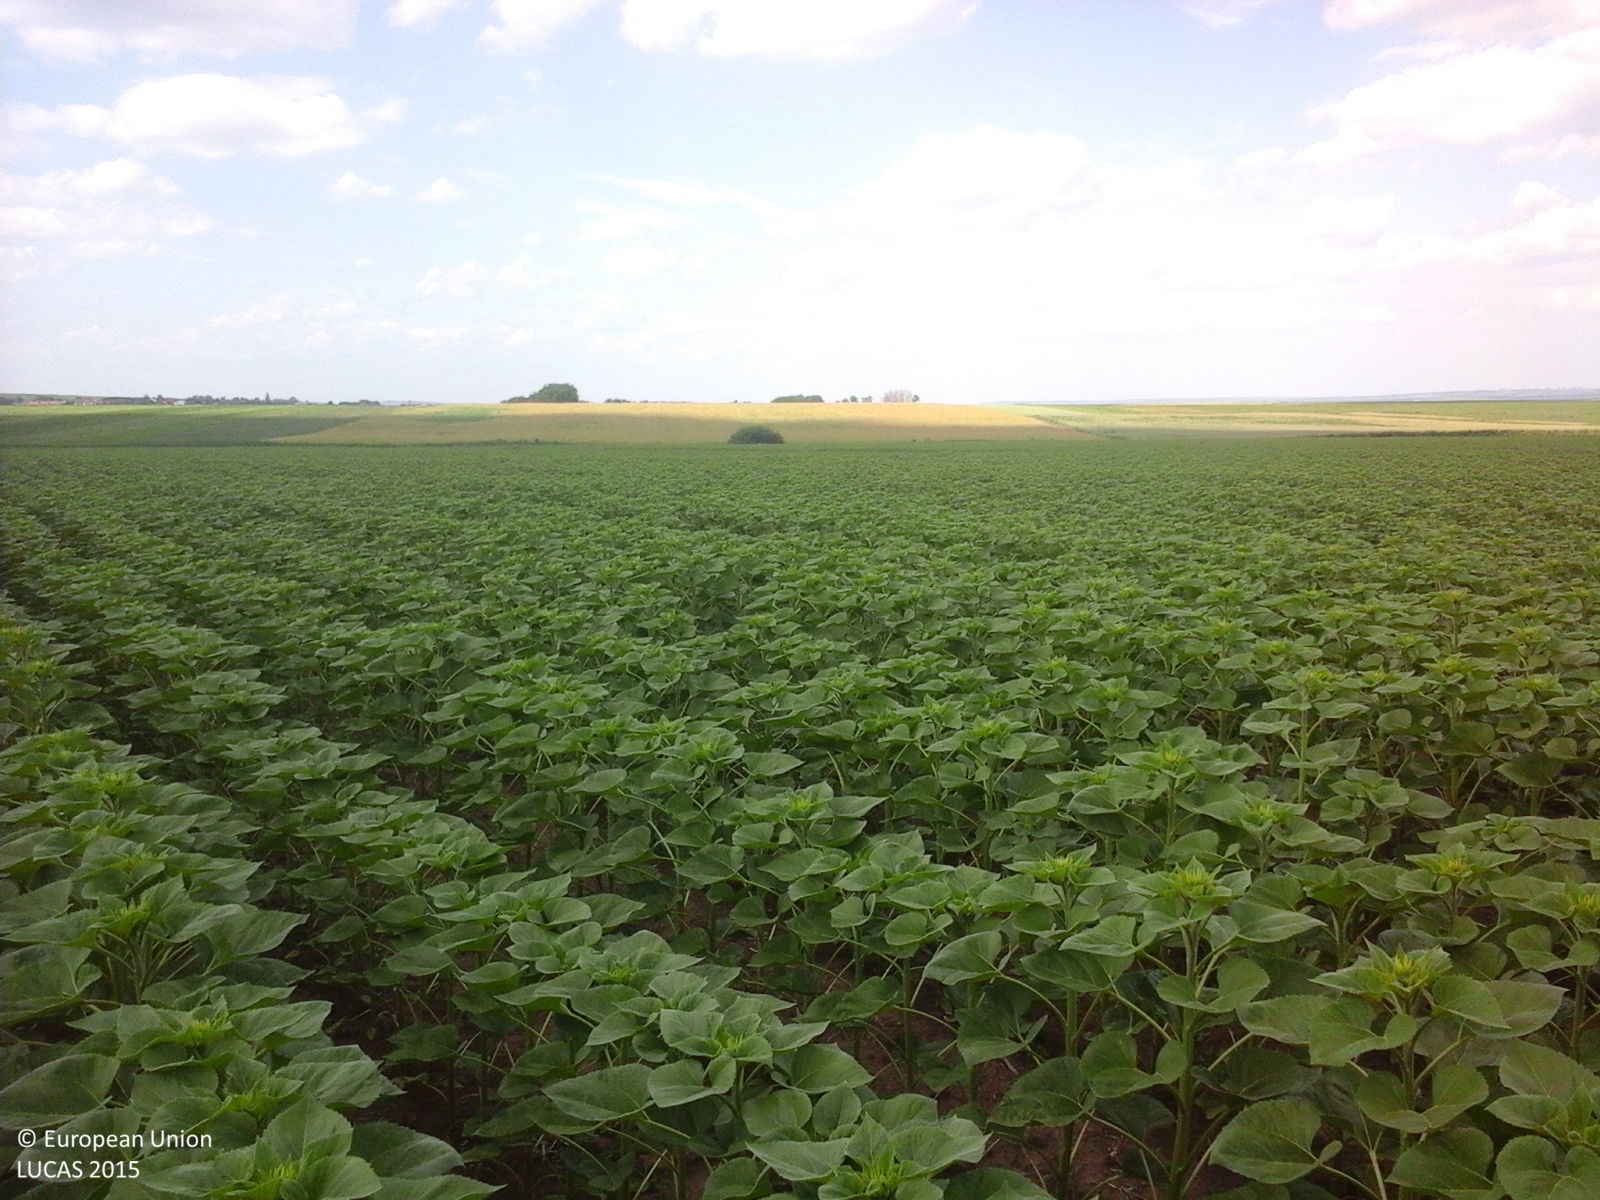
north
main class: Cropland
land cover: Sunflower
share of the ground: > 75 %
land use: Agriculture (excluding fallow land and kitchen gardens)
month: June
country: RO
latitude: 47.8988
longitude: 26.4220
